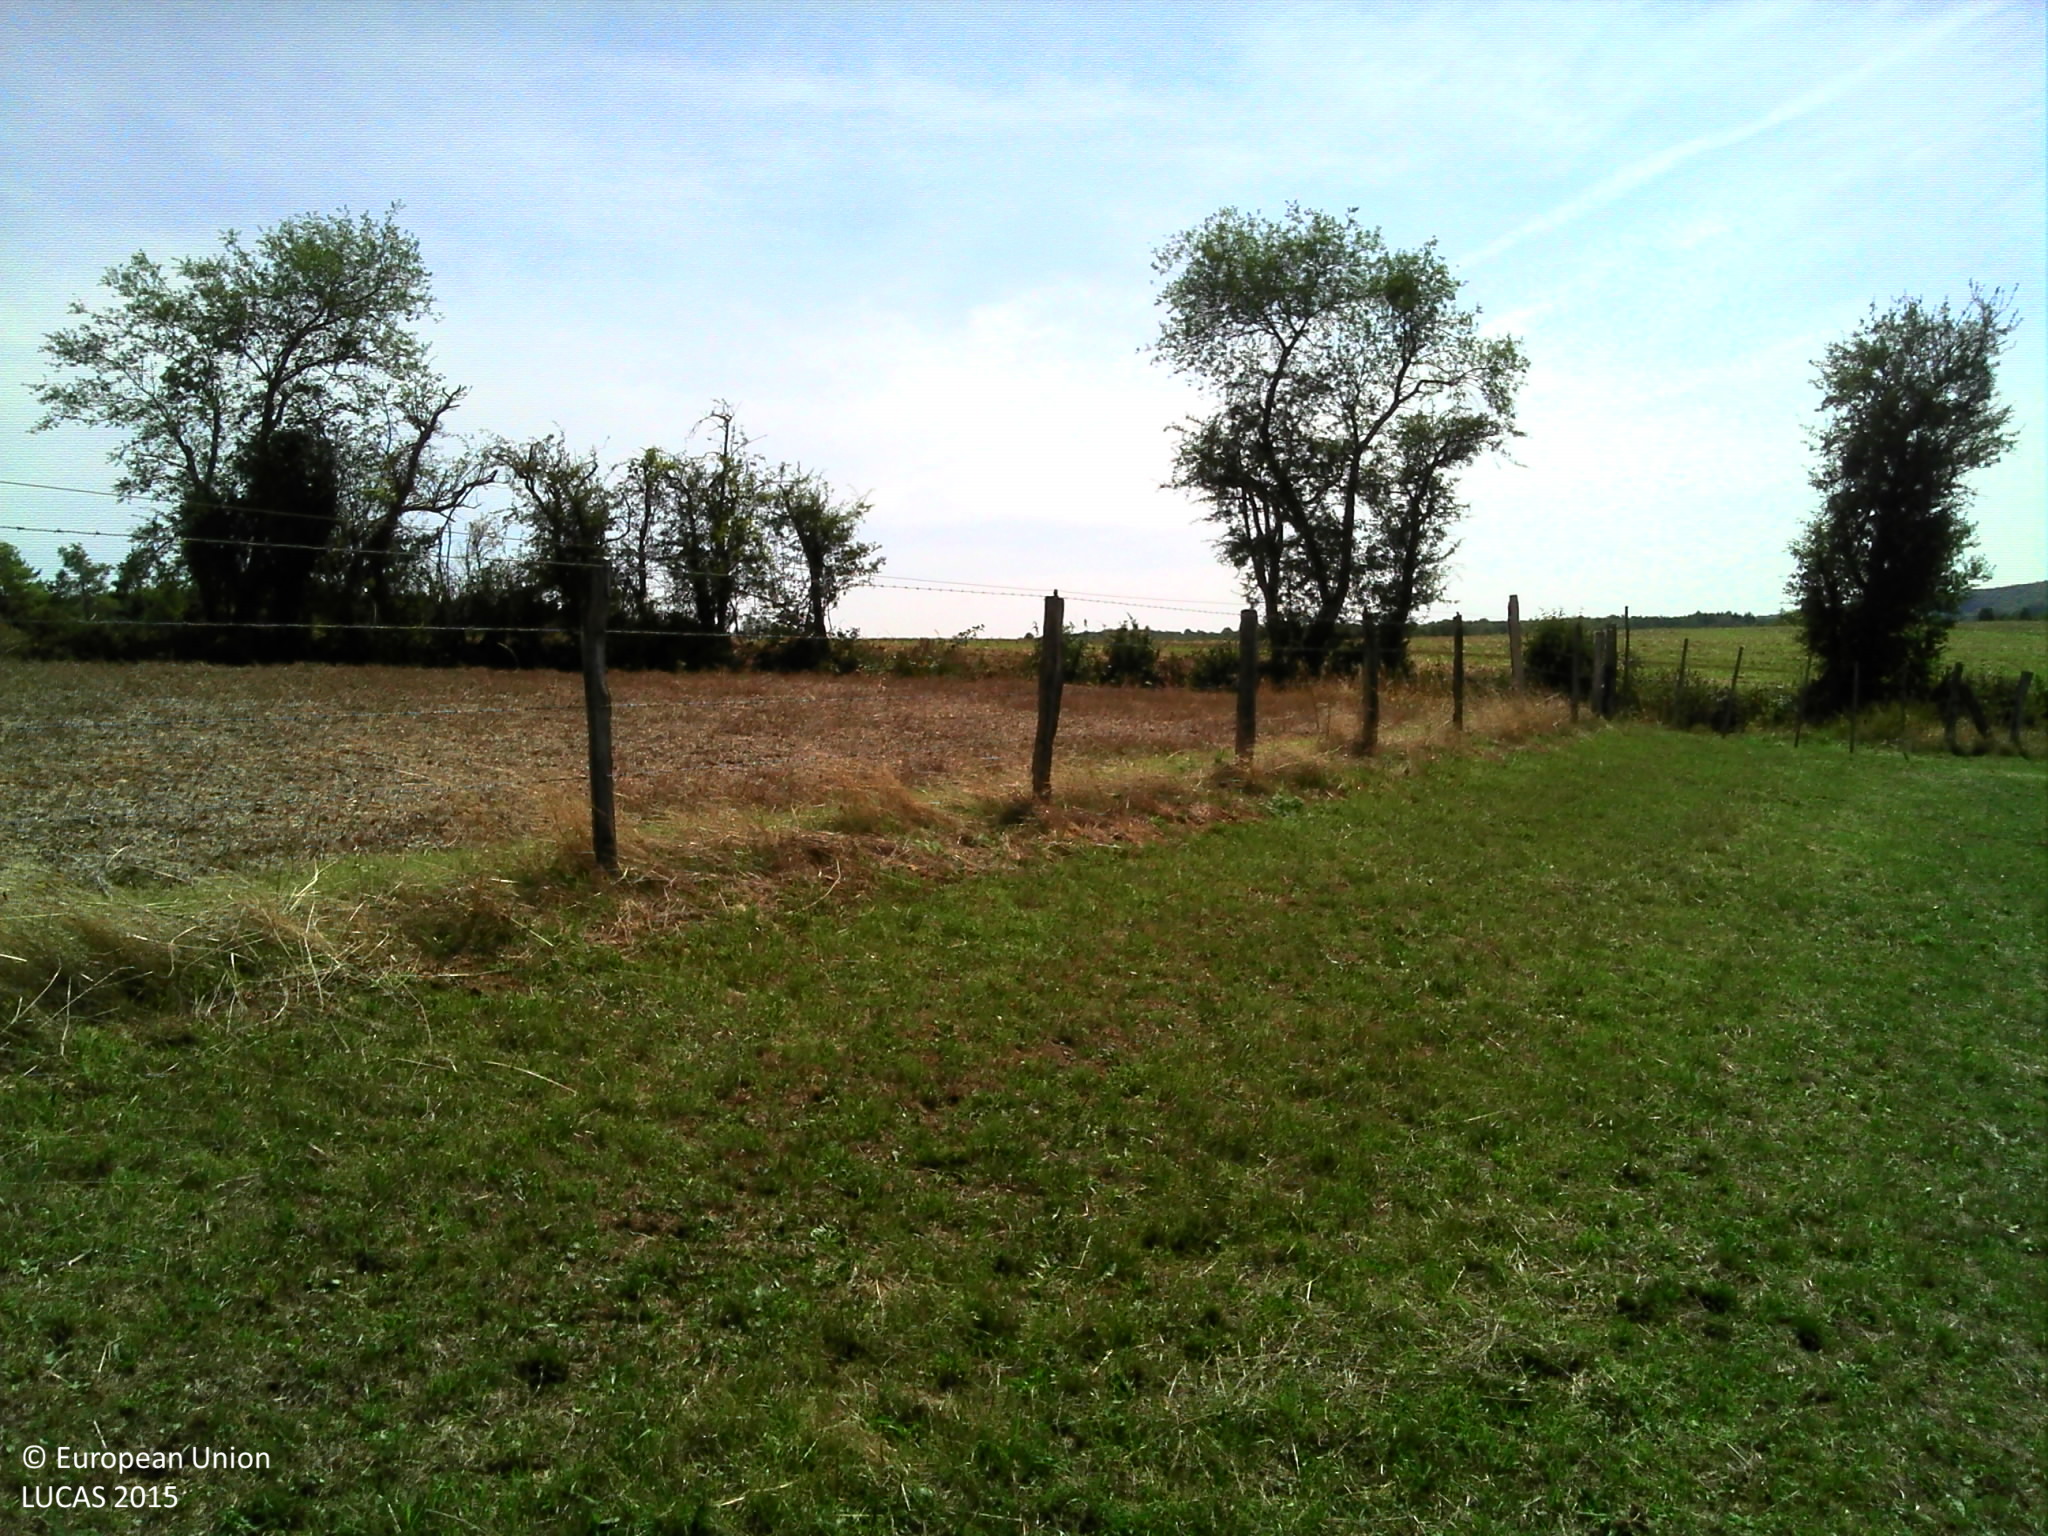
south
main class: Grassland
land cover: Grassland without tree/shrub cover
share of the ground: > 75 %
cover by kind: herbaceous plants 100 %
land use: Agriculture (excluding fallow land and kitchen gardens)
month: August
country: FR
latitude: 47.7470
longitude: 4.9445
